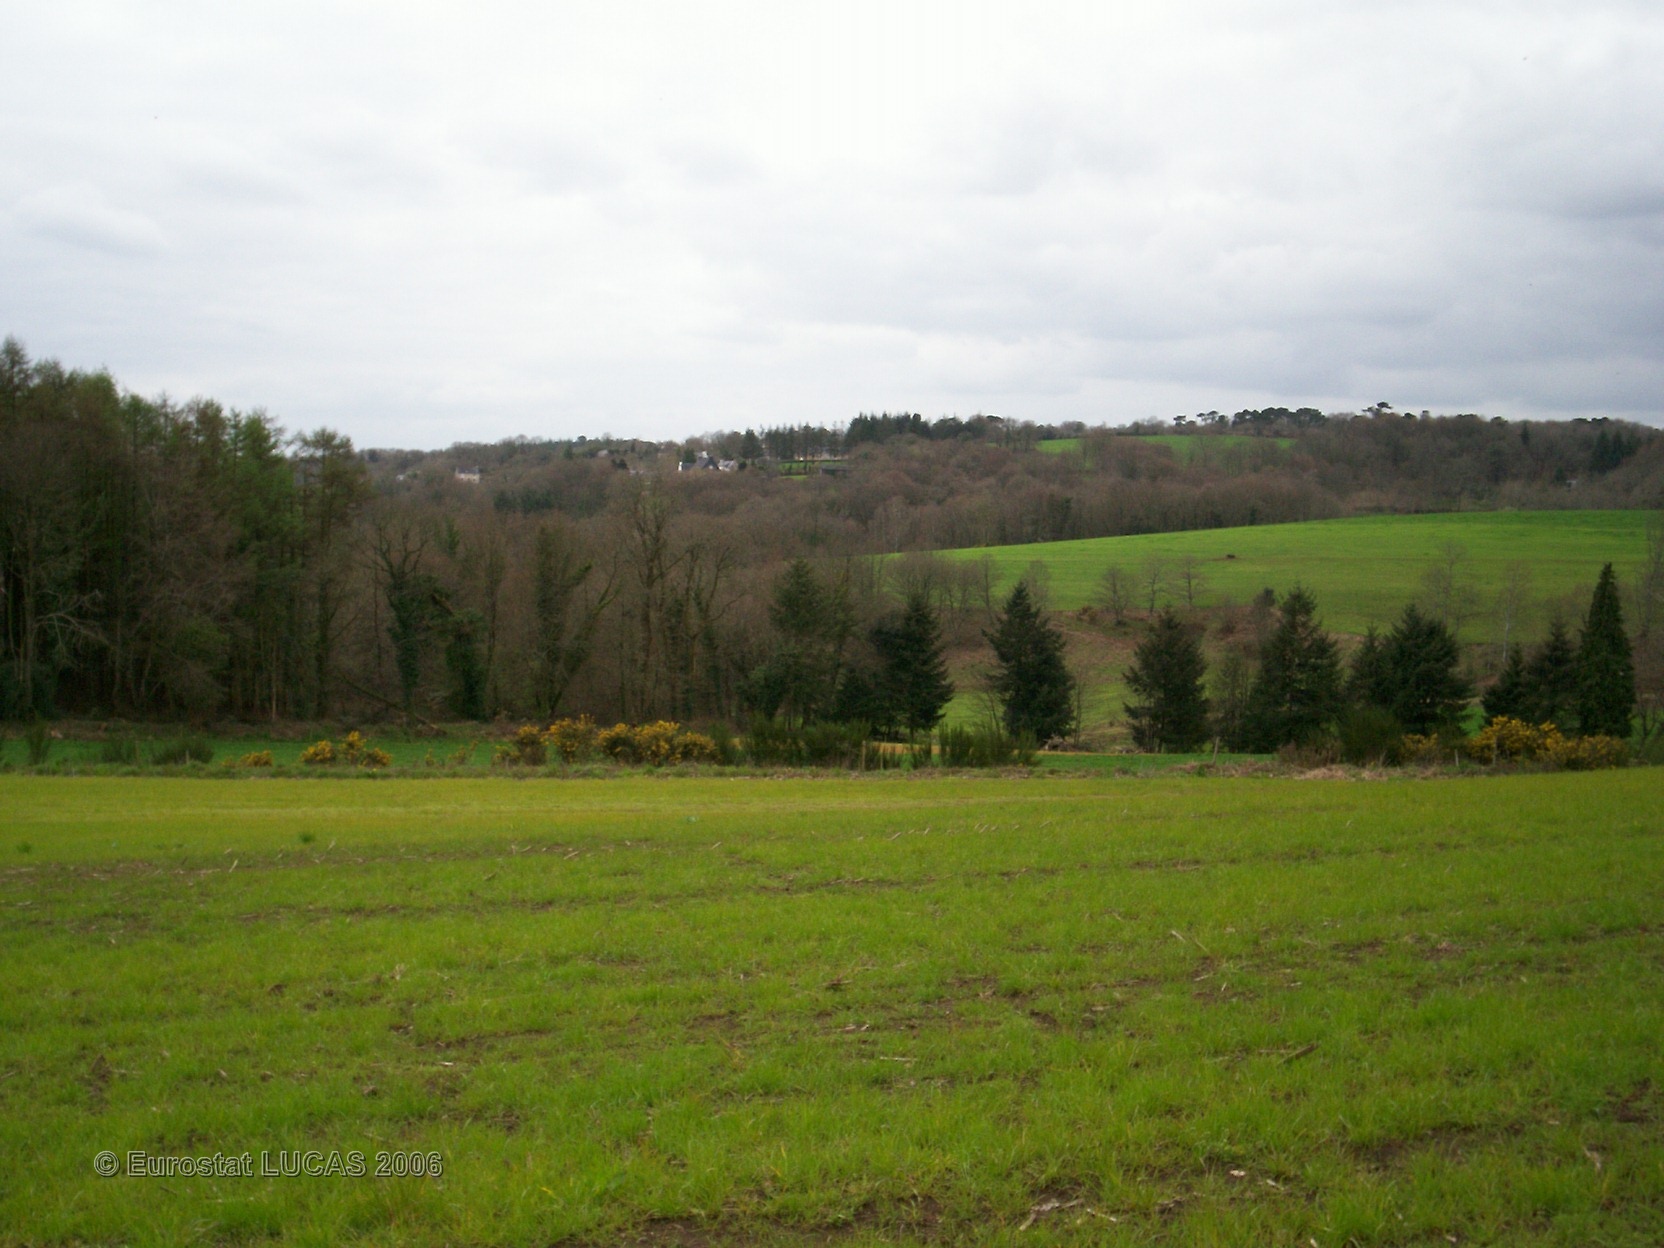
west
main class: Grassland
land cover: Grassland without tree/shrub cover
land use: Agriculture (excluding fallow land and kitchen gardens)
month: April
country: FR
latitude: 48.0027
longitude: -3.5478
